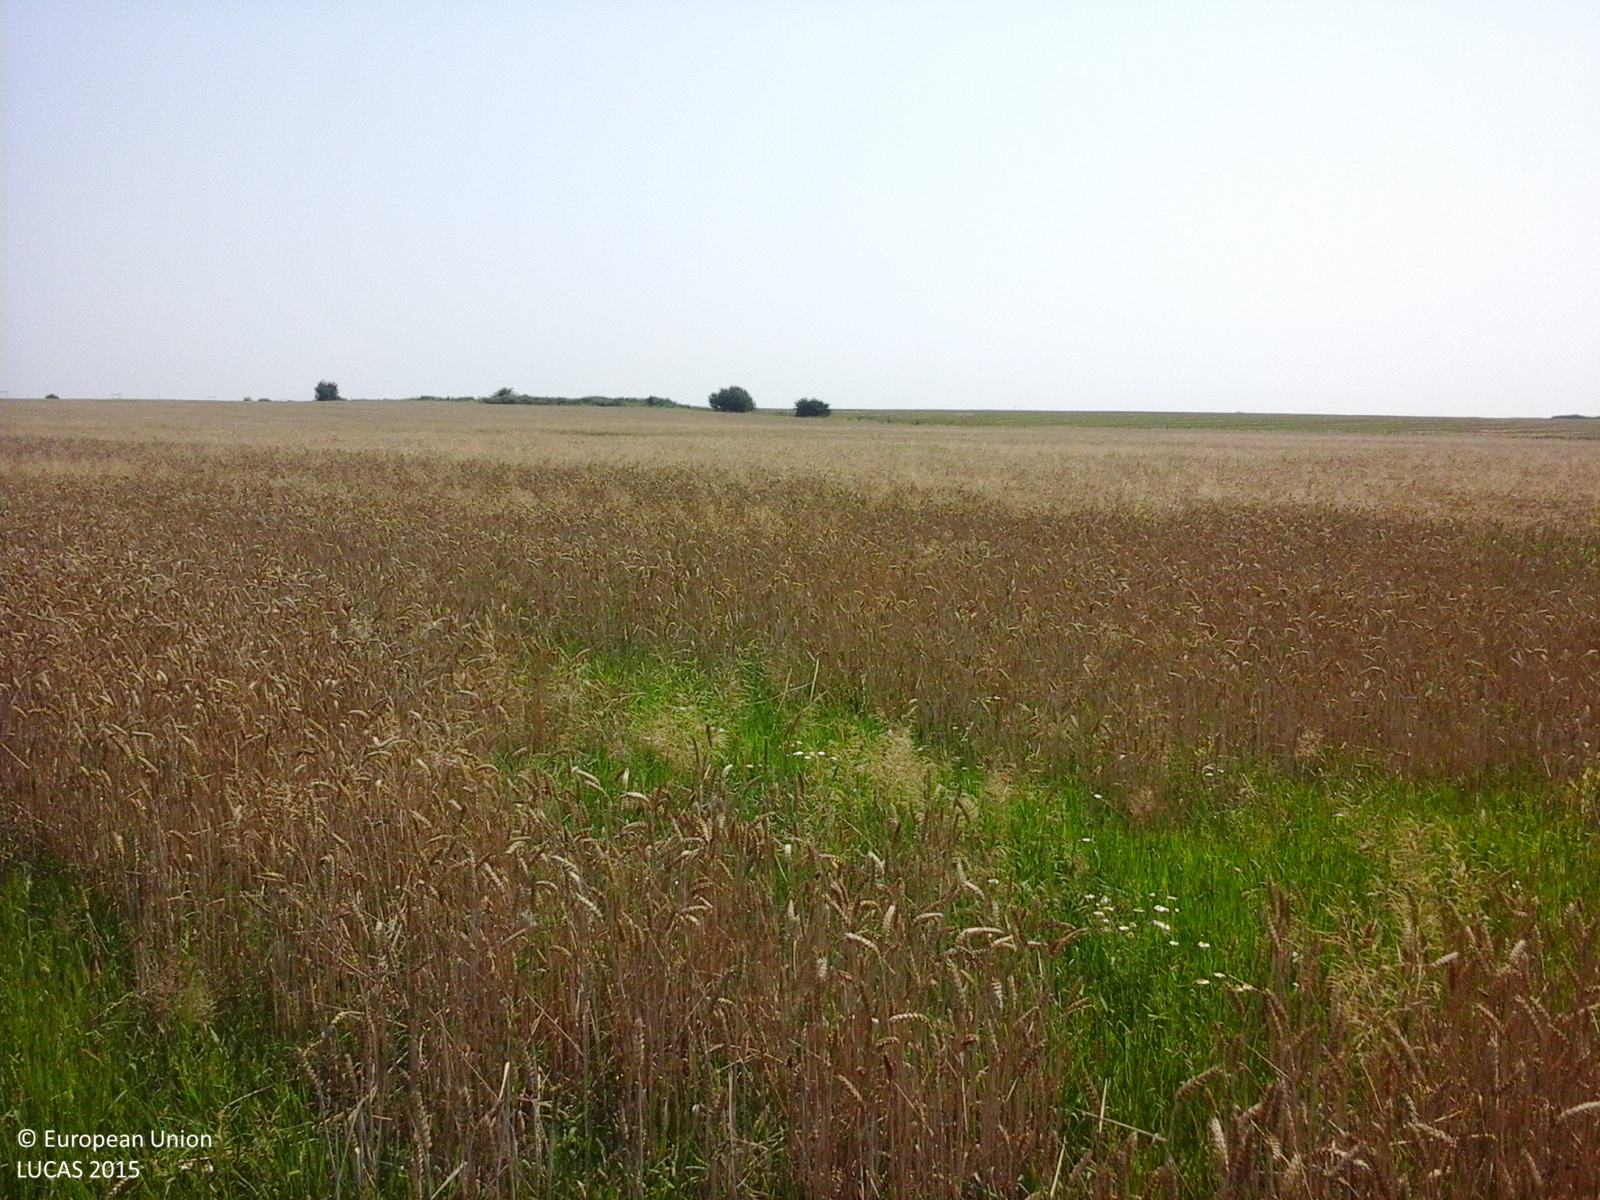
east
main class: Cropland
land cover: Common wheat
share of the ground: > 75 %
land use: Agriculture (excluding fallow land and kitchen gardens)
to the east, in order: Common wheat; Grass margins; Ditches and canals; Grass margins; Common wheat
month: July
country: RO
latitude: 44.5092
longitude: 25.4239
